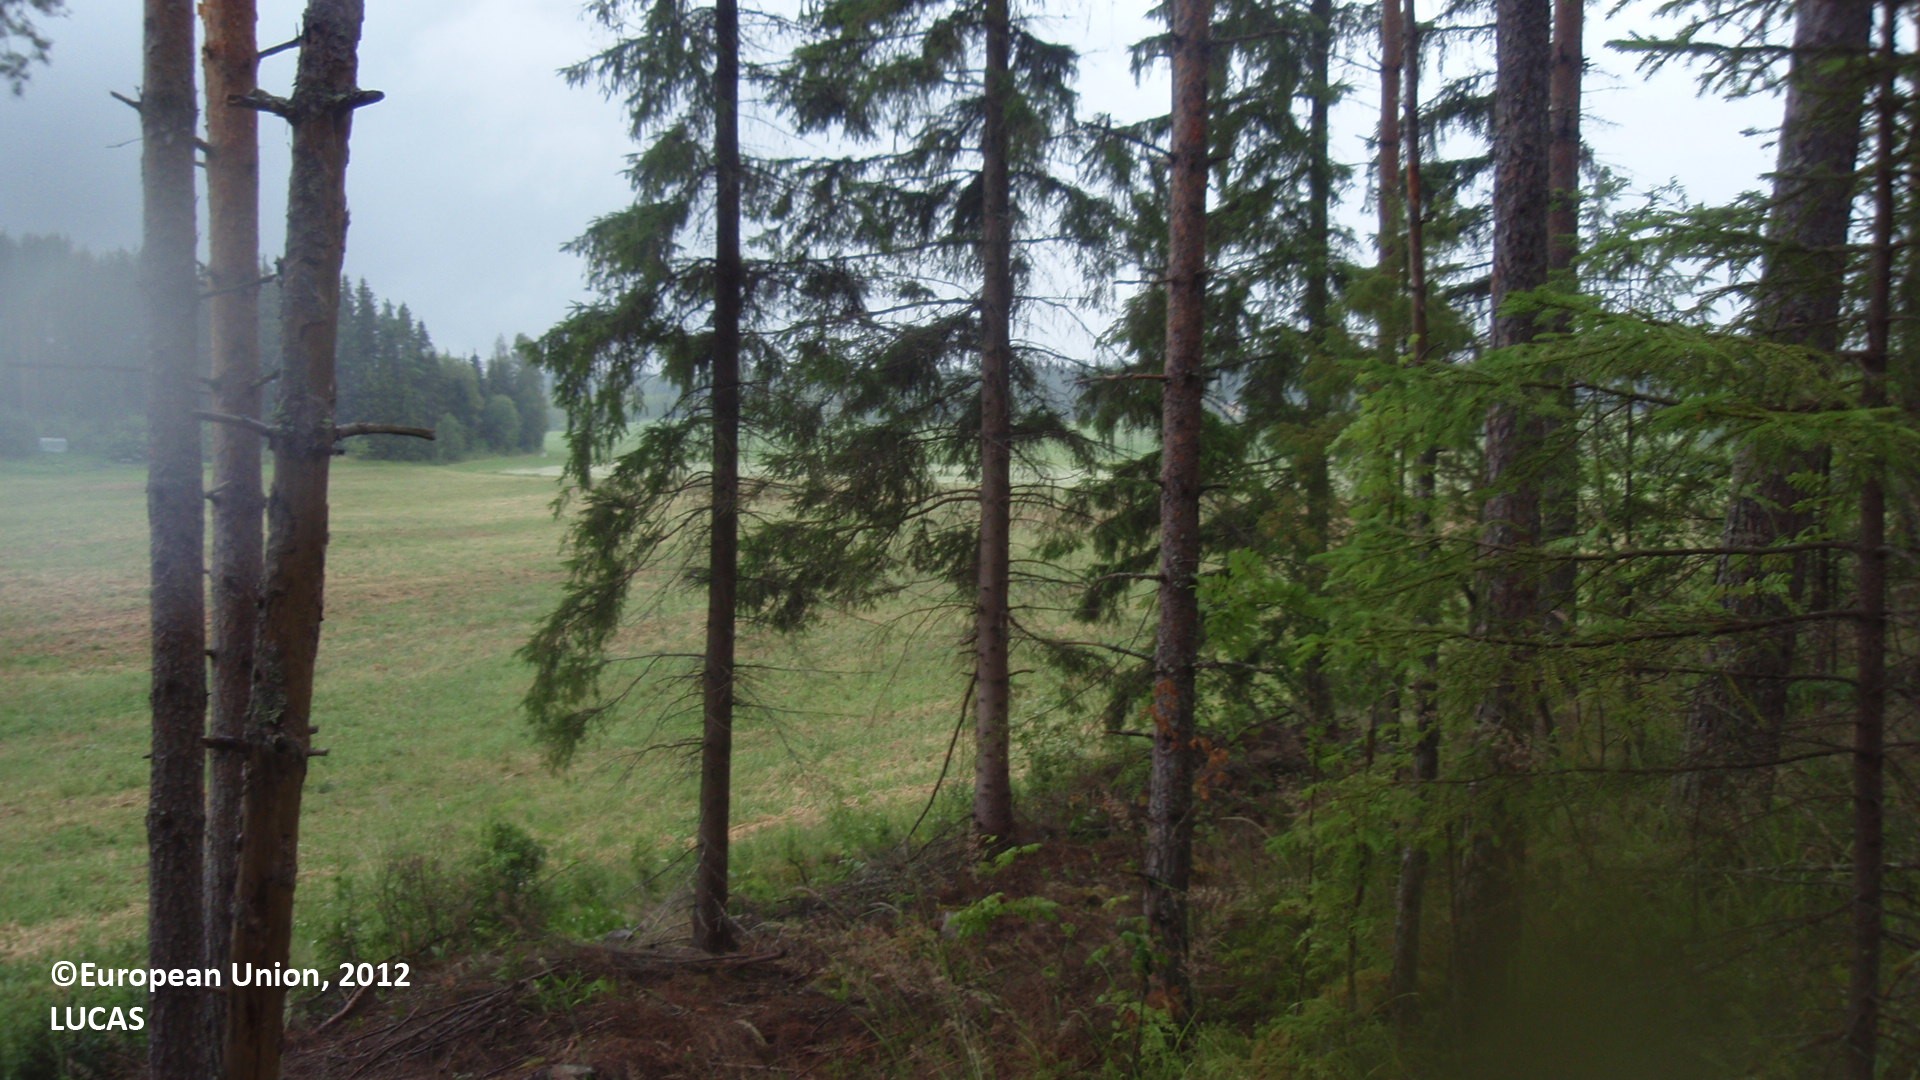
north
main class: Woodland
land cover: Pine dominated mixed woodland
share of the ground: 25 - 50 %
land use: Forestry
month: July
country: FI
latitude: 61.1207
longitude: 28.7297
